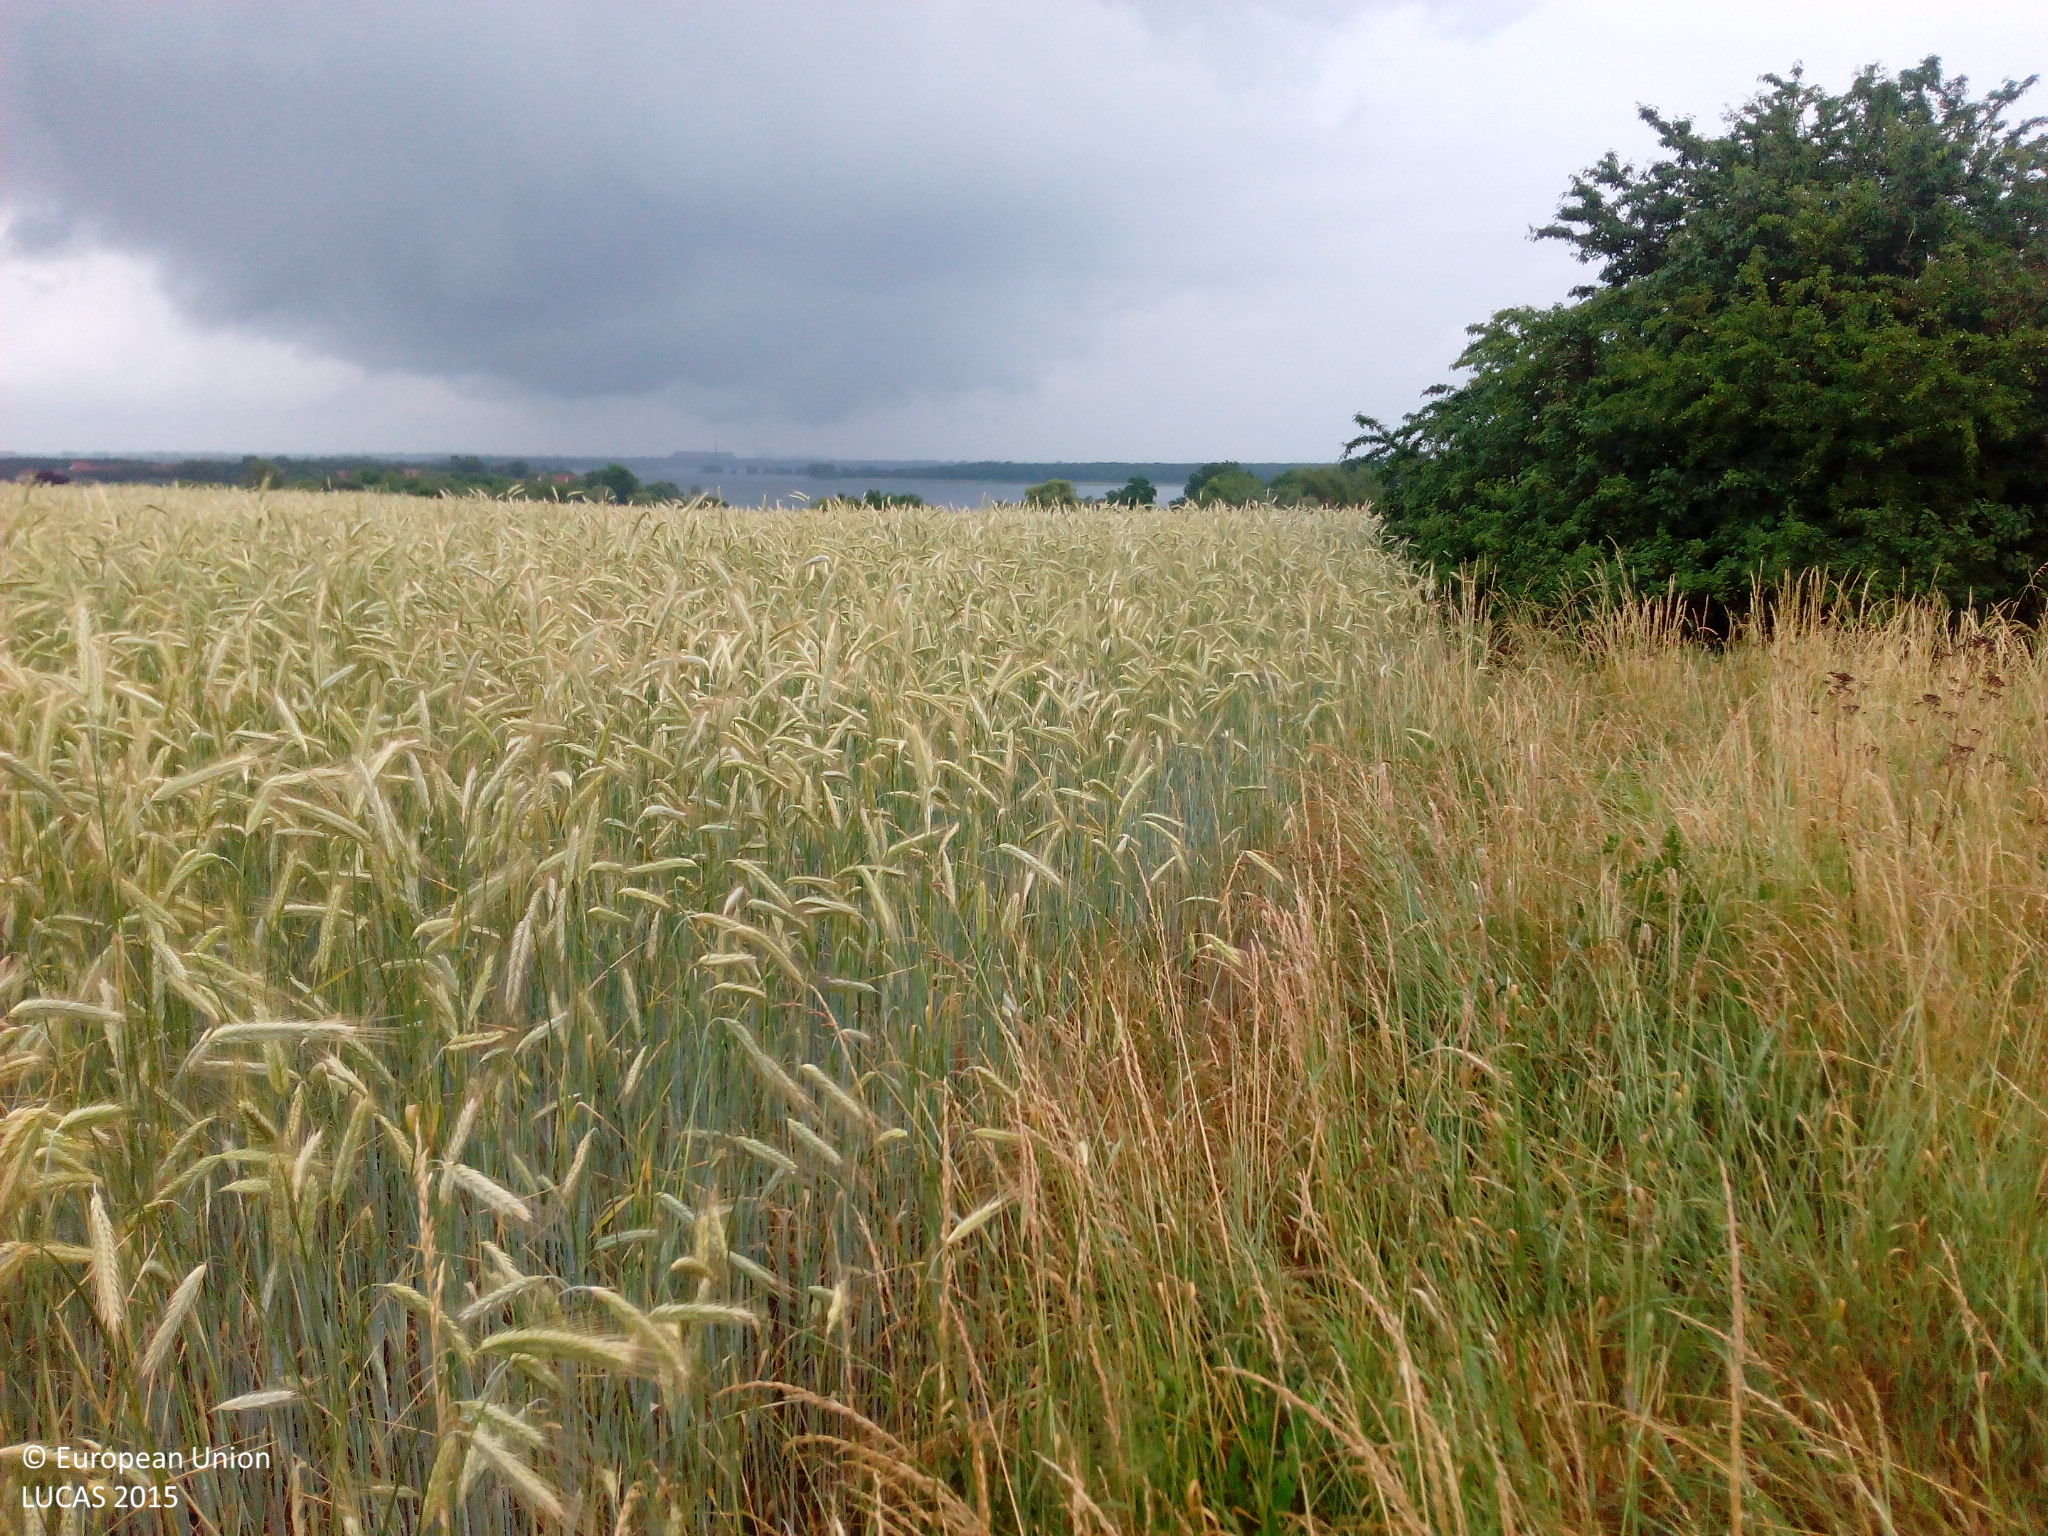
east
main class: Cropland
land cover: Rye
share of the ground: > 75 %
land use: Agriculture (excluding fallow land and kitchen gardens)
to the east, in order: Rye; Broadleaved woodland; Grassland without tree/shrub cover; Paved roads, cycling and walking lanes; Broadleaved woodland
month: June
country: DE
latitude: 52.3708
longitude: 12.4231
